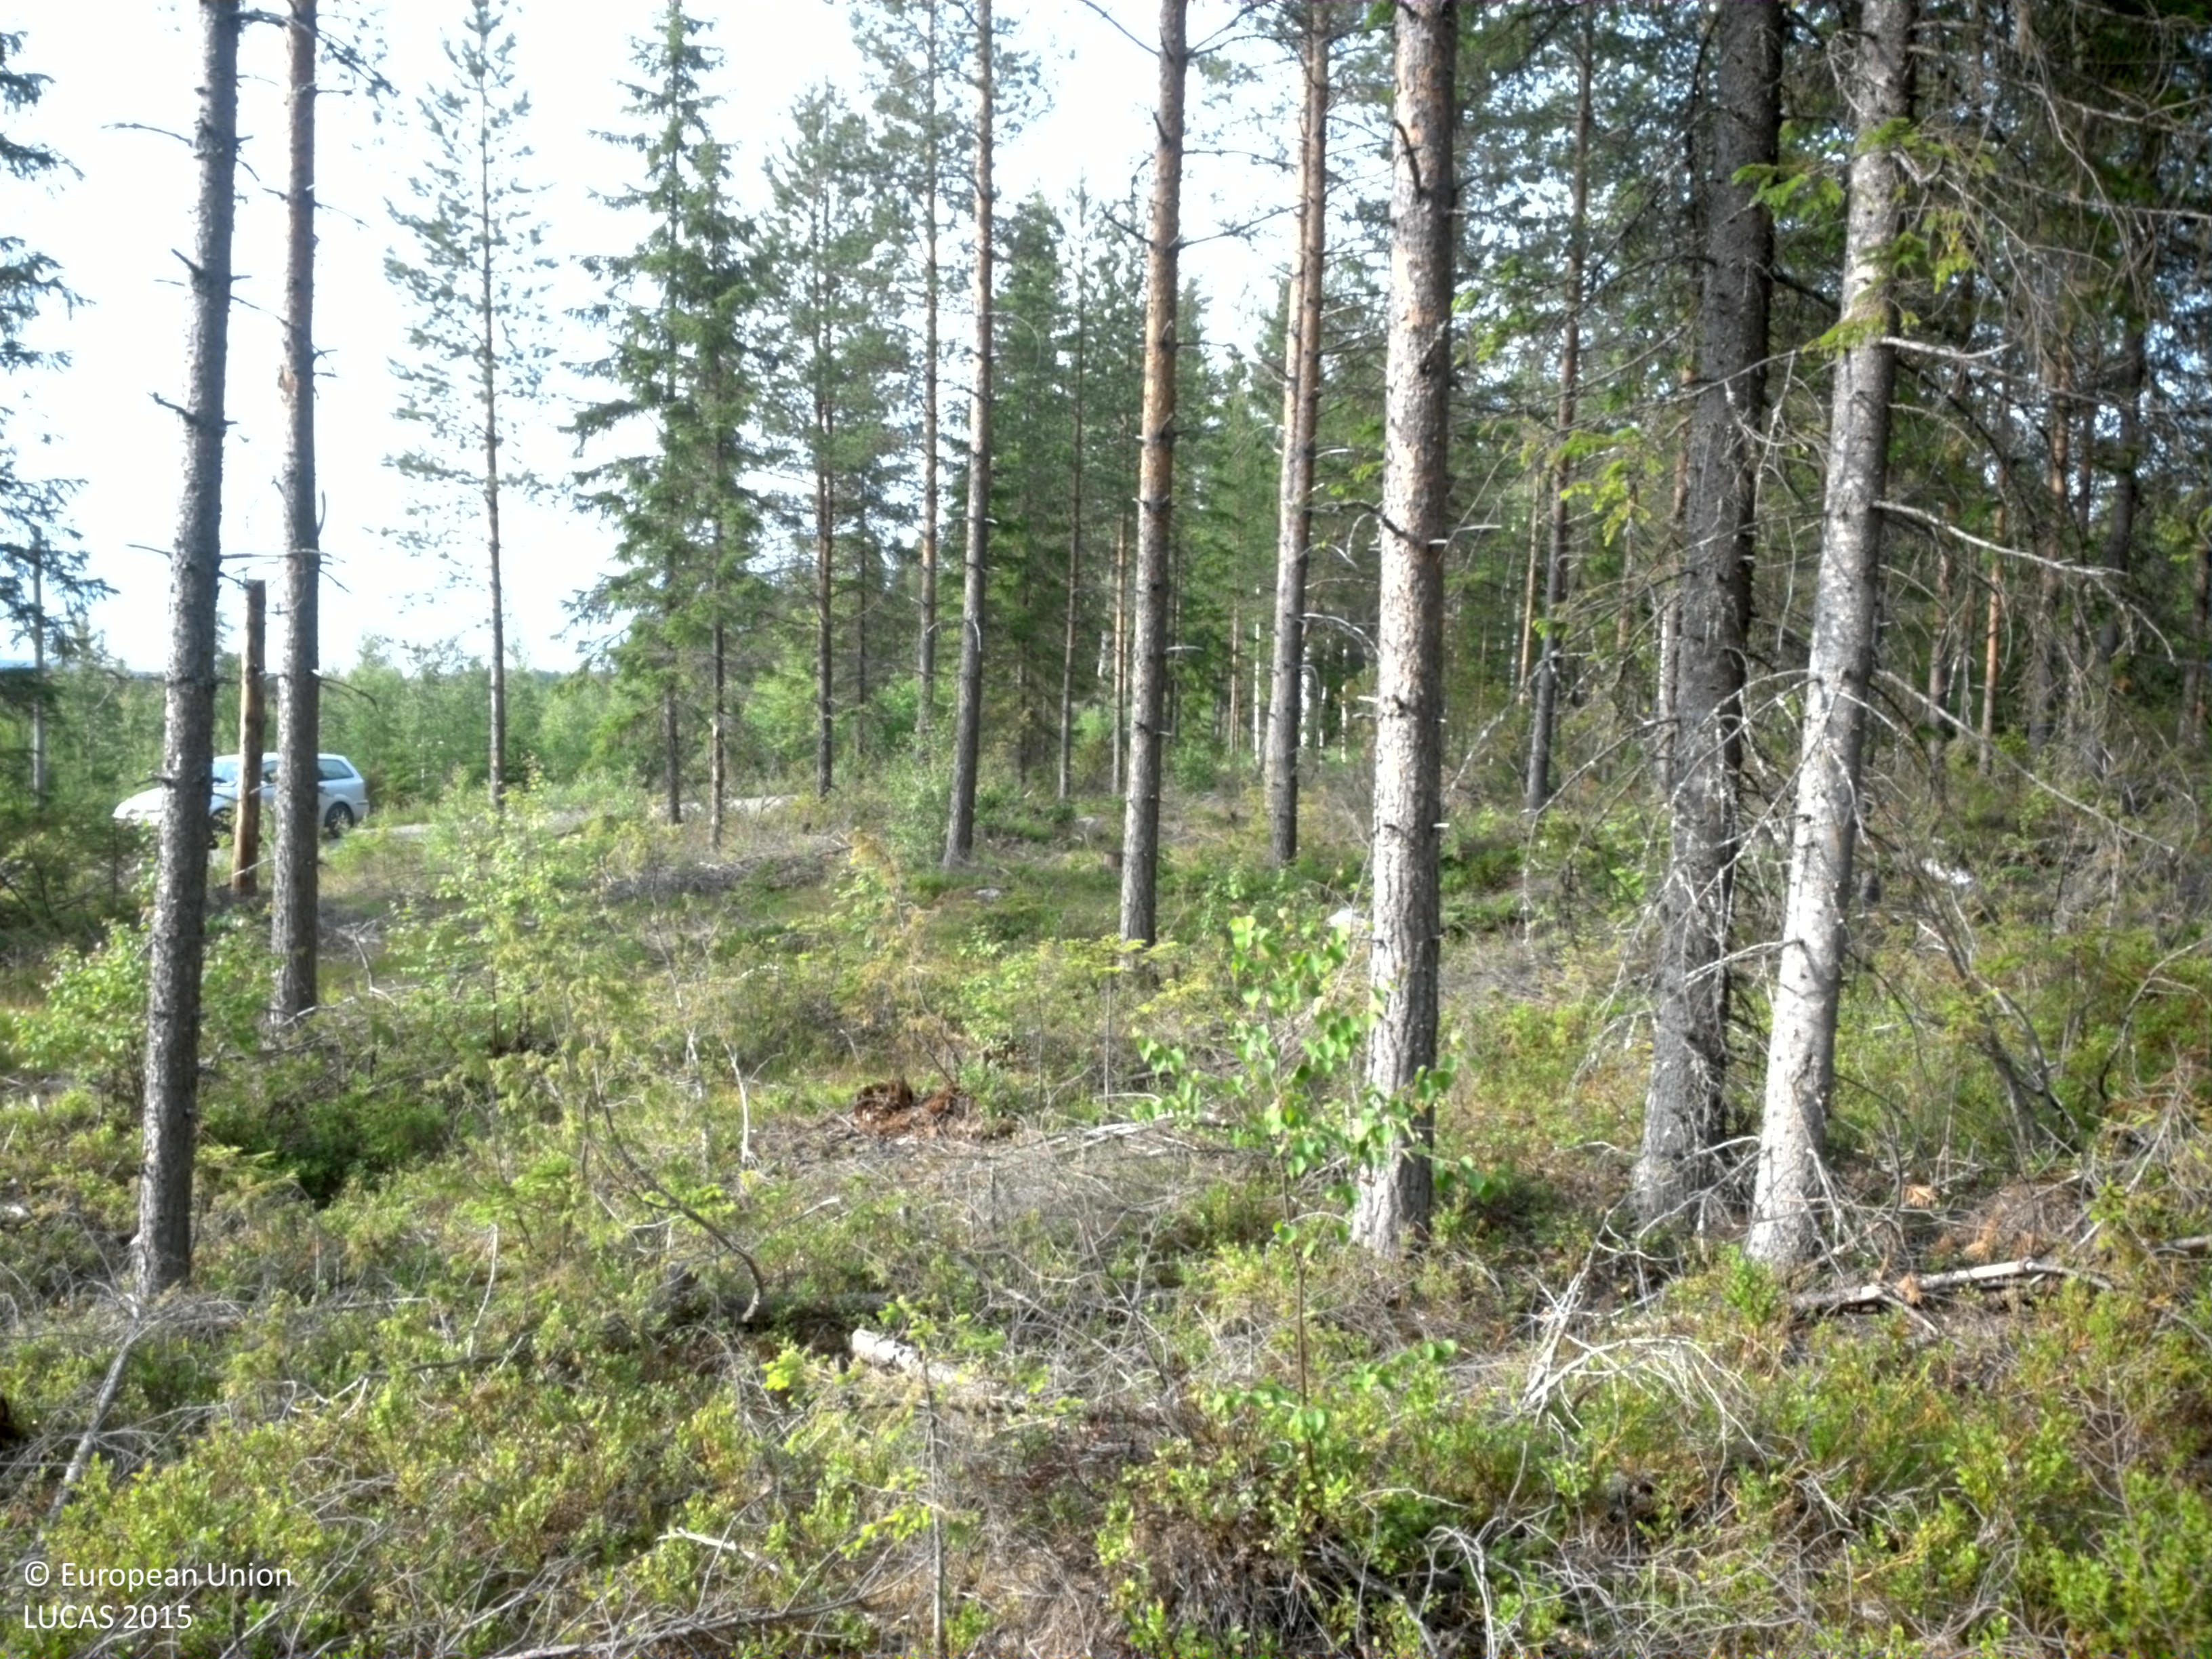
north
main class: Woodland
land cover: Pine dominated coniferous woodland
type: boreal forest
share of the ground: 50 - 75 %
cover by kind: coniferous forest trees 75 %, shrubs 20 %, herbaceous plants 5 %
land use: Forestry
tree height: > 5 m
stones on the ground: > 50 %
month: July
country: SE
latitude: 64.4662
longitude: 20.8128
